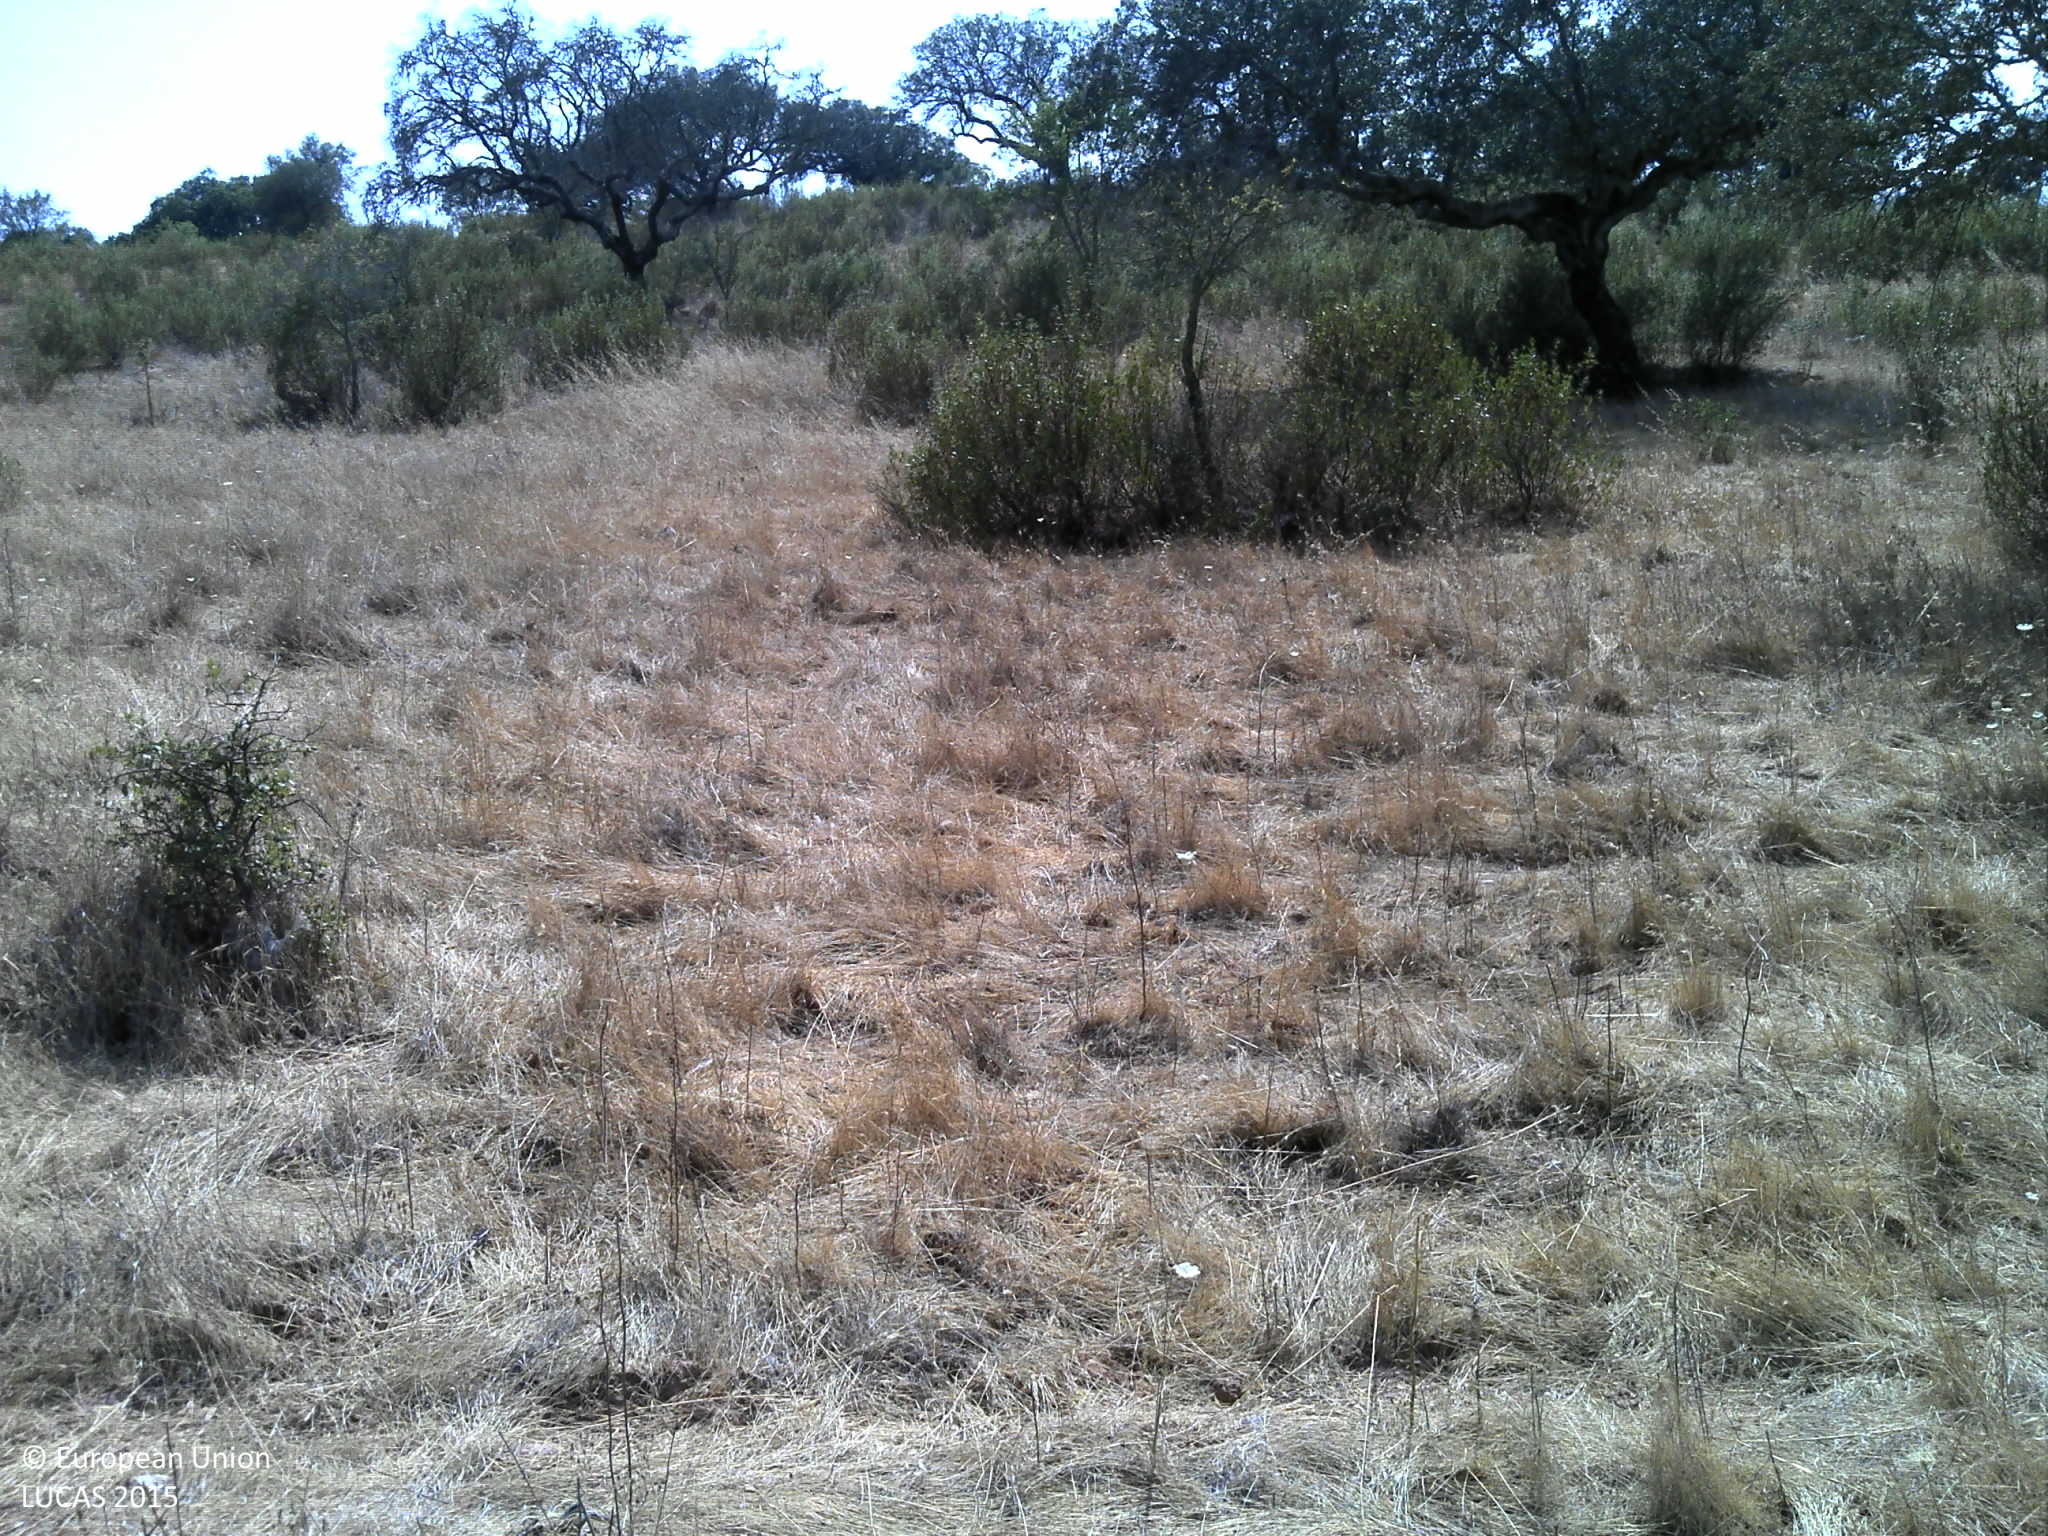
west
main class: Woodland
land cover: Broadleaved woodland
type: broadleaved evergreen forest
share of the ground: 10 - 25 %
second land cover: Grassland without tree/shrub cover
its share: 50 - 75 %
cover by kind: herbaceous plants 50 %, consolidated bare surface 35 %, broadleaved forest trees 15 %
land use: Forestry
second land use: Agriculture (excluding fallow land and kitchen gardens)
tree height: > 5 m
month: July
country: PT
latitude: 37.6387
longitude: -8.2172
